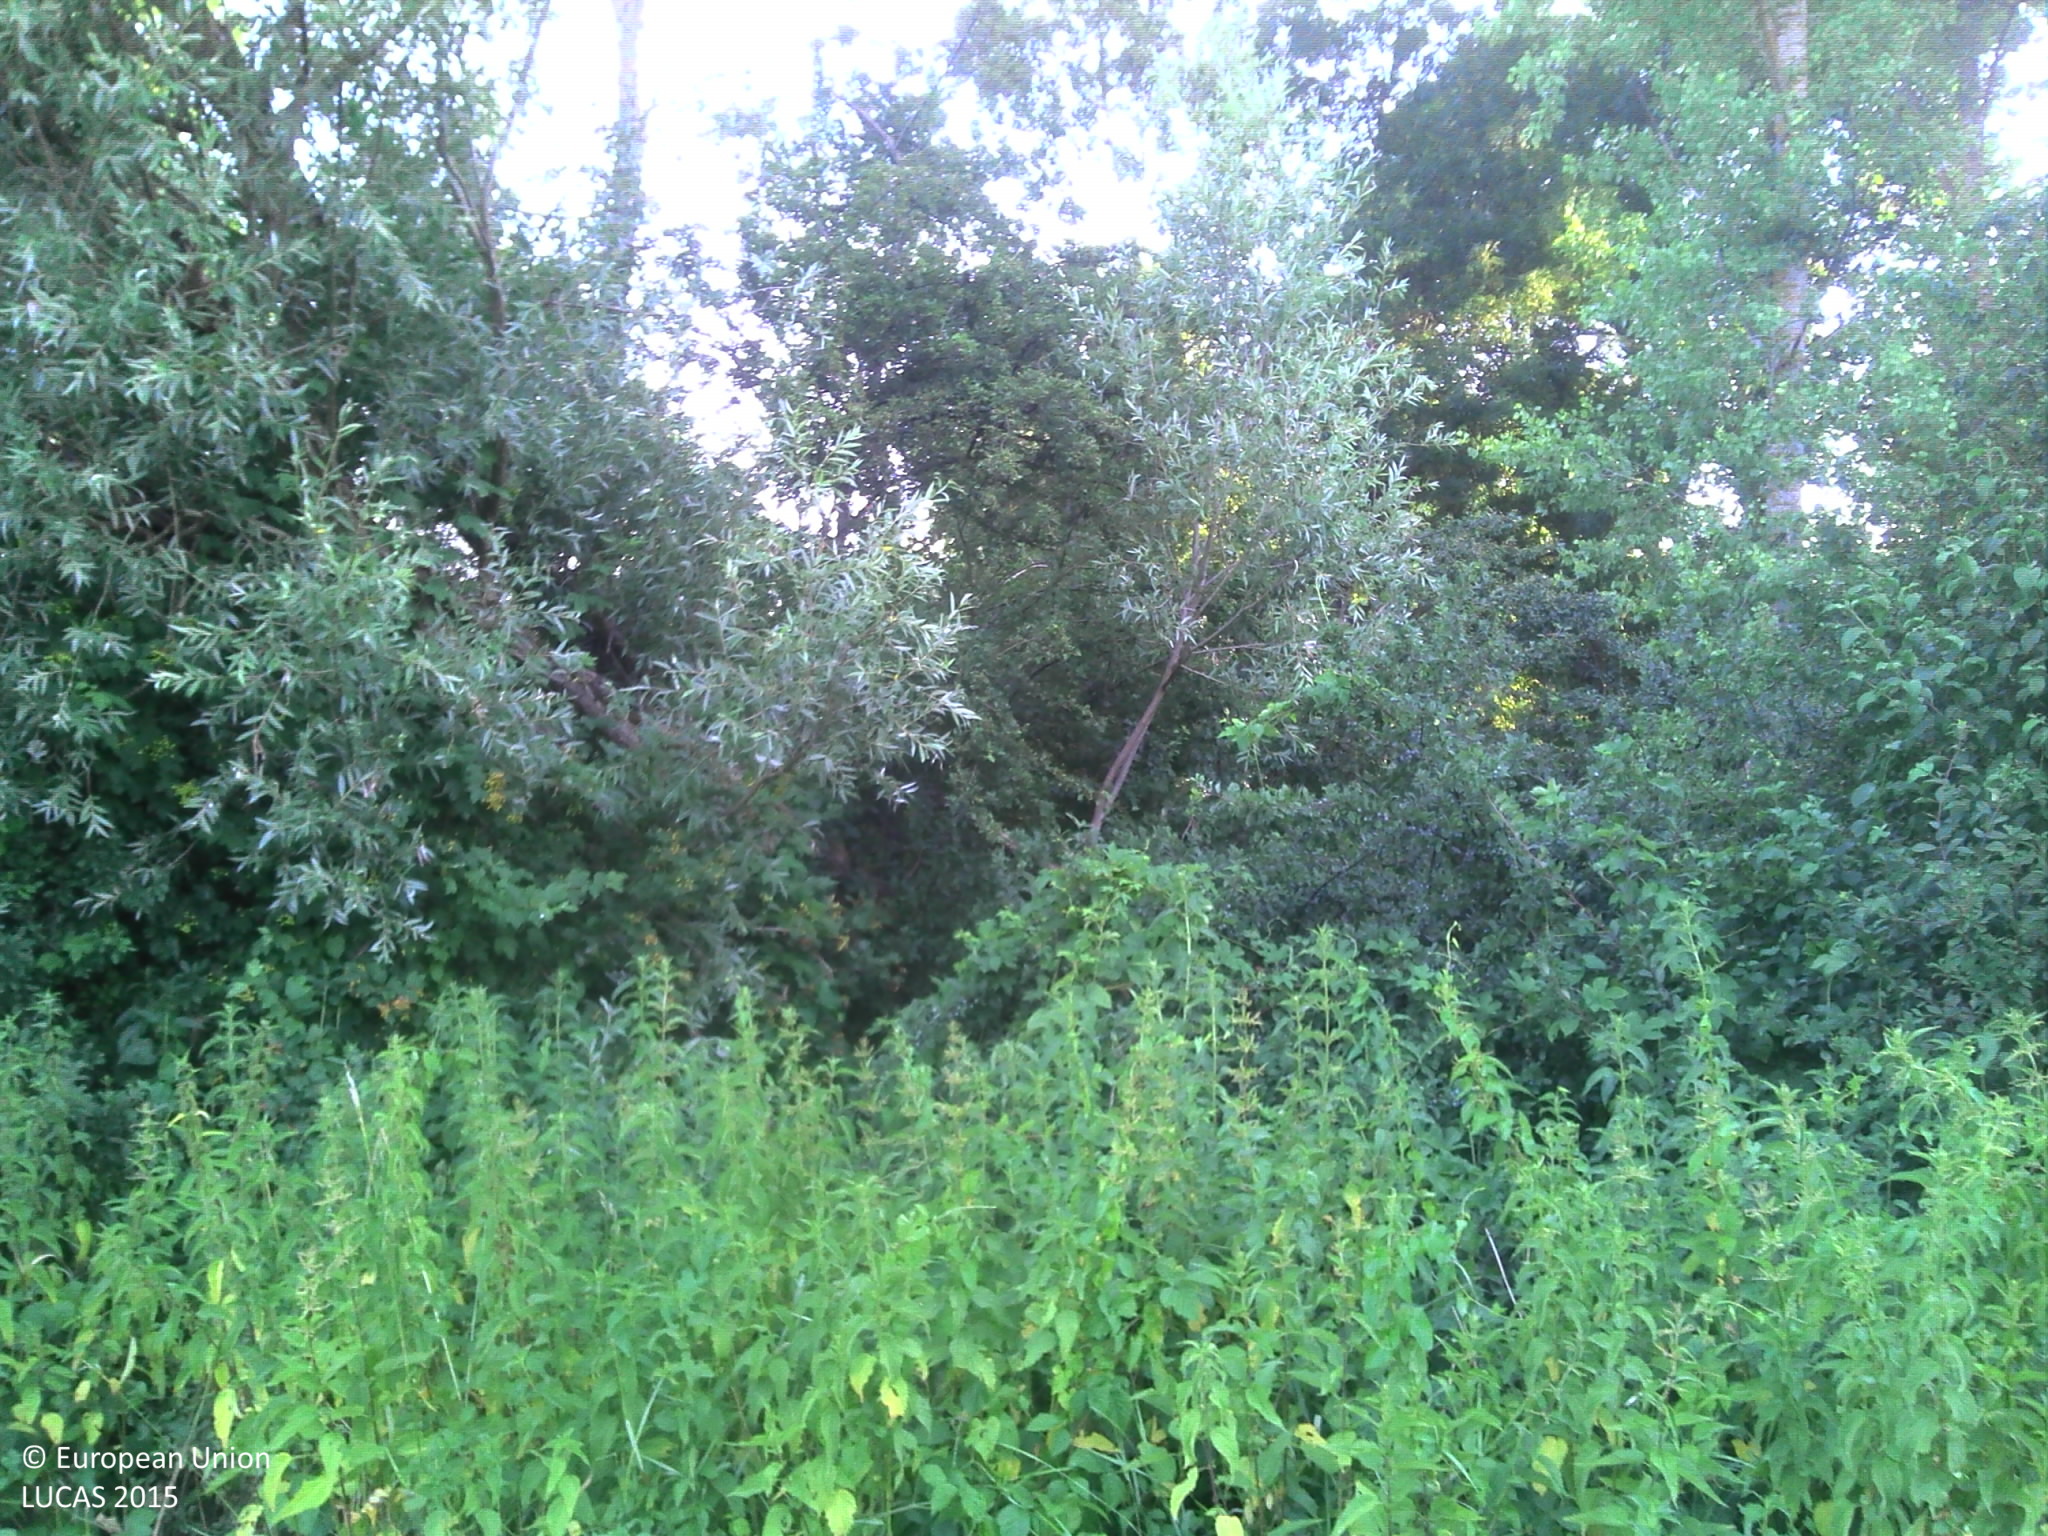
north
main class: Grassland
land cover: Grassland without tree/shrub cover
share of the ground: > 75 %
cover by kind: herbaceous plants 100 %
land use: Agriculture (excluding fallow land and kitchen gardens)
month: July
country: FR
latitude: 46.9305
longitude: 5.2338
